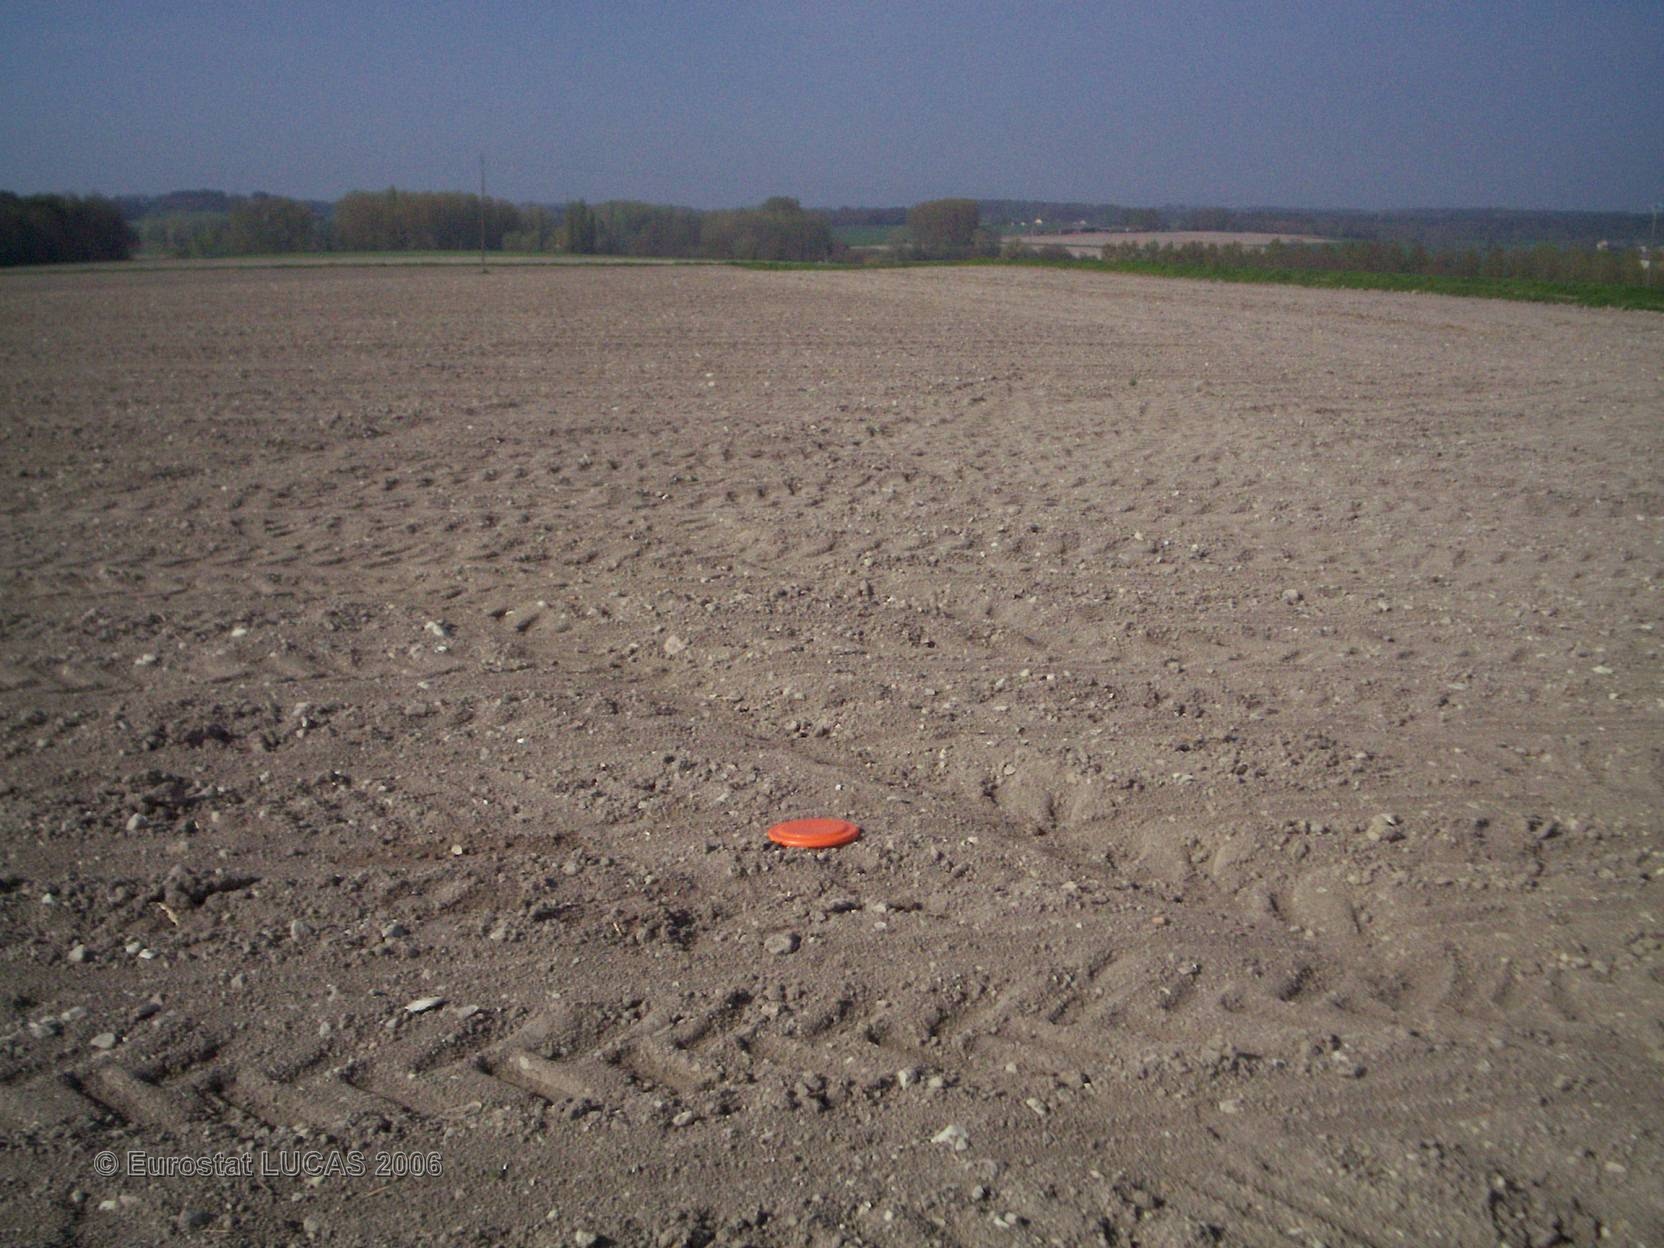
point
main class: Bare land
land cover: Bare land
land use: Agriculture (excluding fallow land and kitchen gardens)
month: April
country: FR
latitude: 46.8807
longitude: 0.4143
